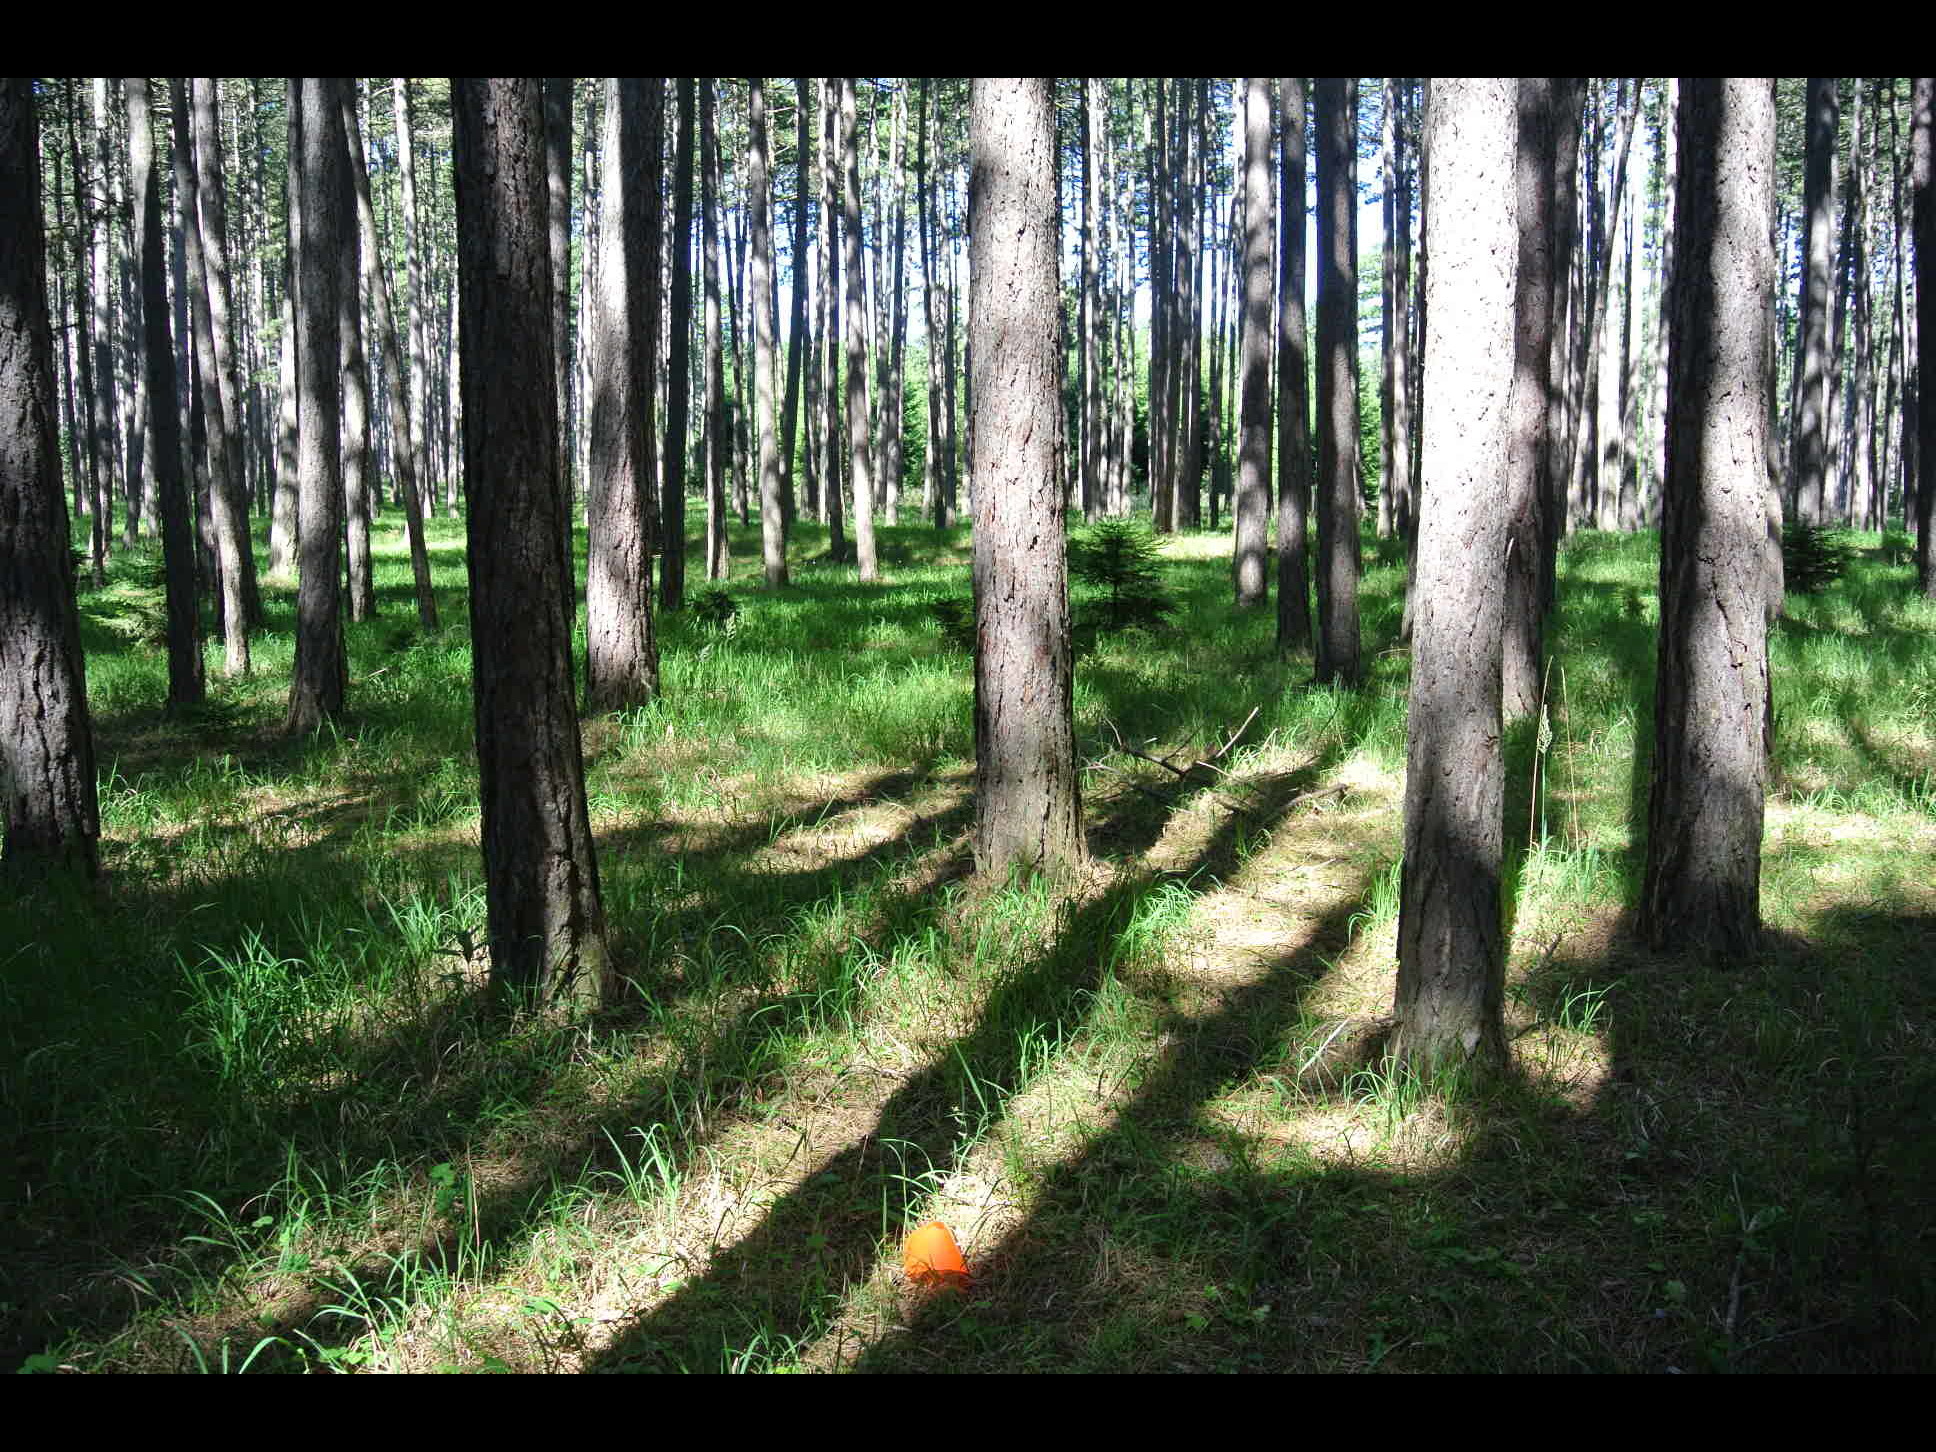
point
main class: Woodland
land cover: Pine dominated coniferous woodland
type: alpine coniferous forest
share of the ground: > 75 %
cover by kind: coniferous forest trees 100 %
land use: Forestry
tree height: > 5 m
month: July
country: AT
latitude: 47.7494
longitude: 16.0719
